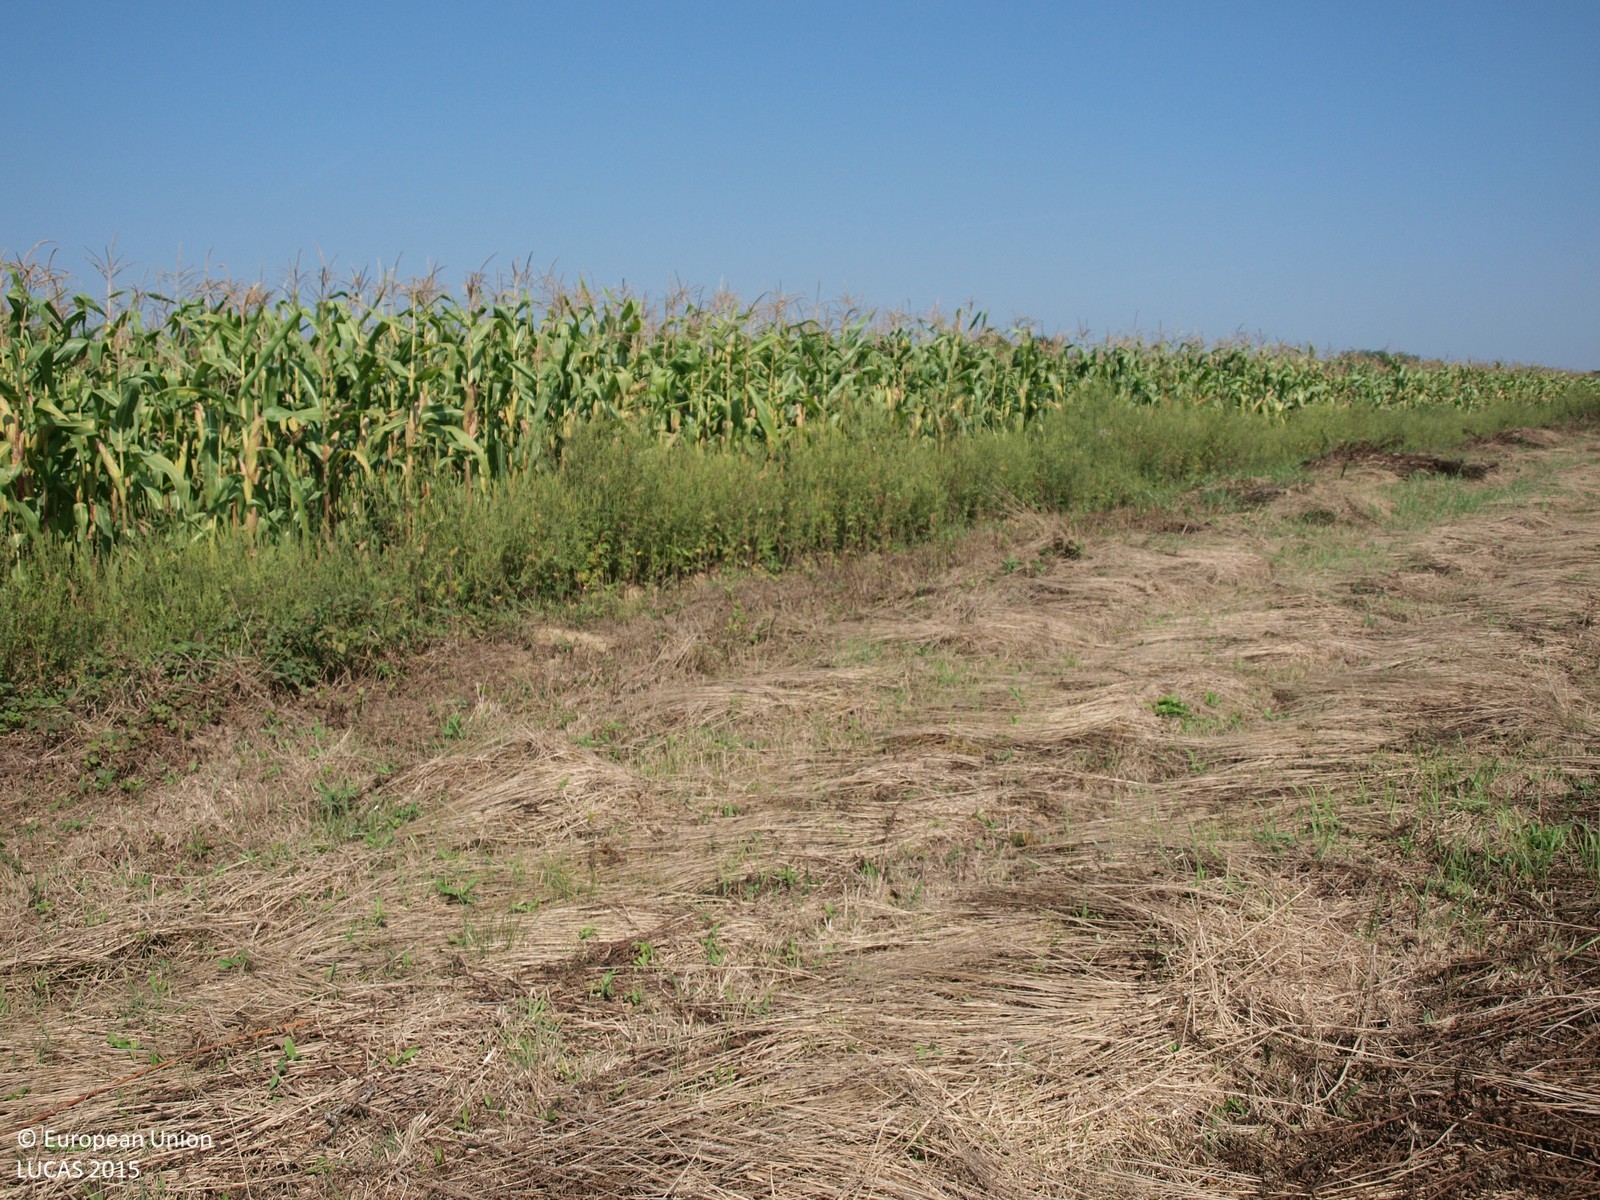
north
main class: Grassland
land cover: Grassland without tree/shrub cover
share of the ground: > 75 %
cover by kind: herbaceous plants 100 %
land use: Agriculture (excluding fallow land and kitchen gardens)
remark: Harvested field
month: August
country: HR
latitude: 45.6831
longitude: 16.5083
